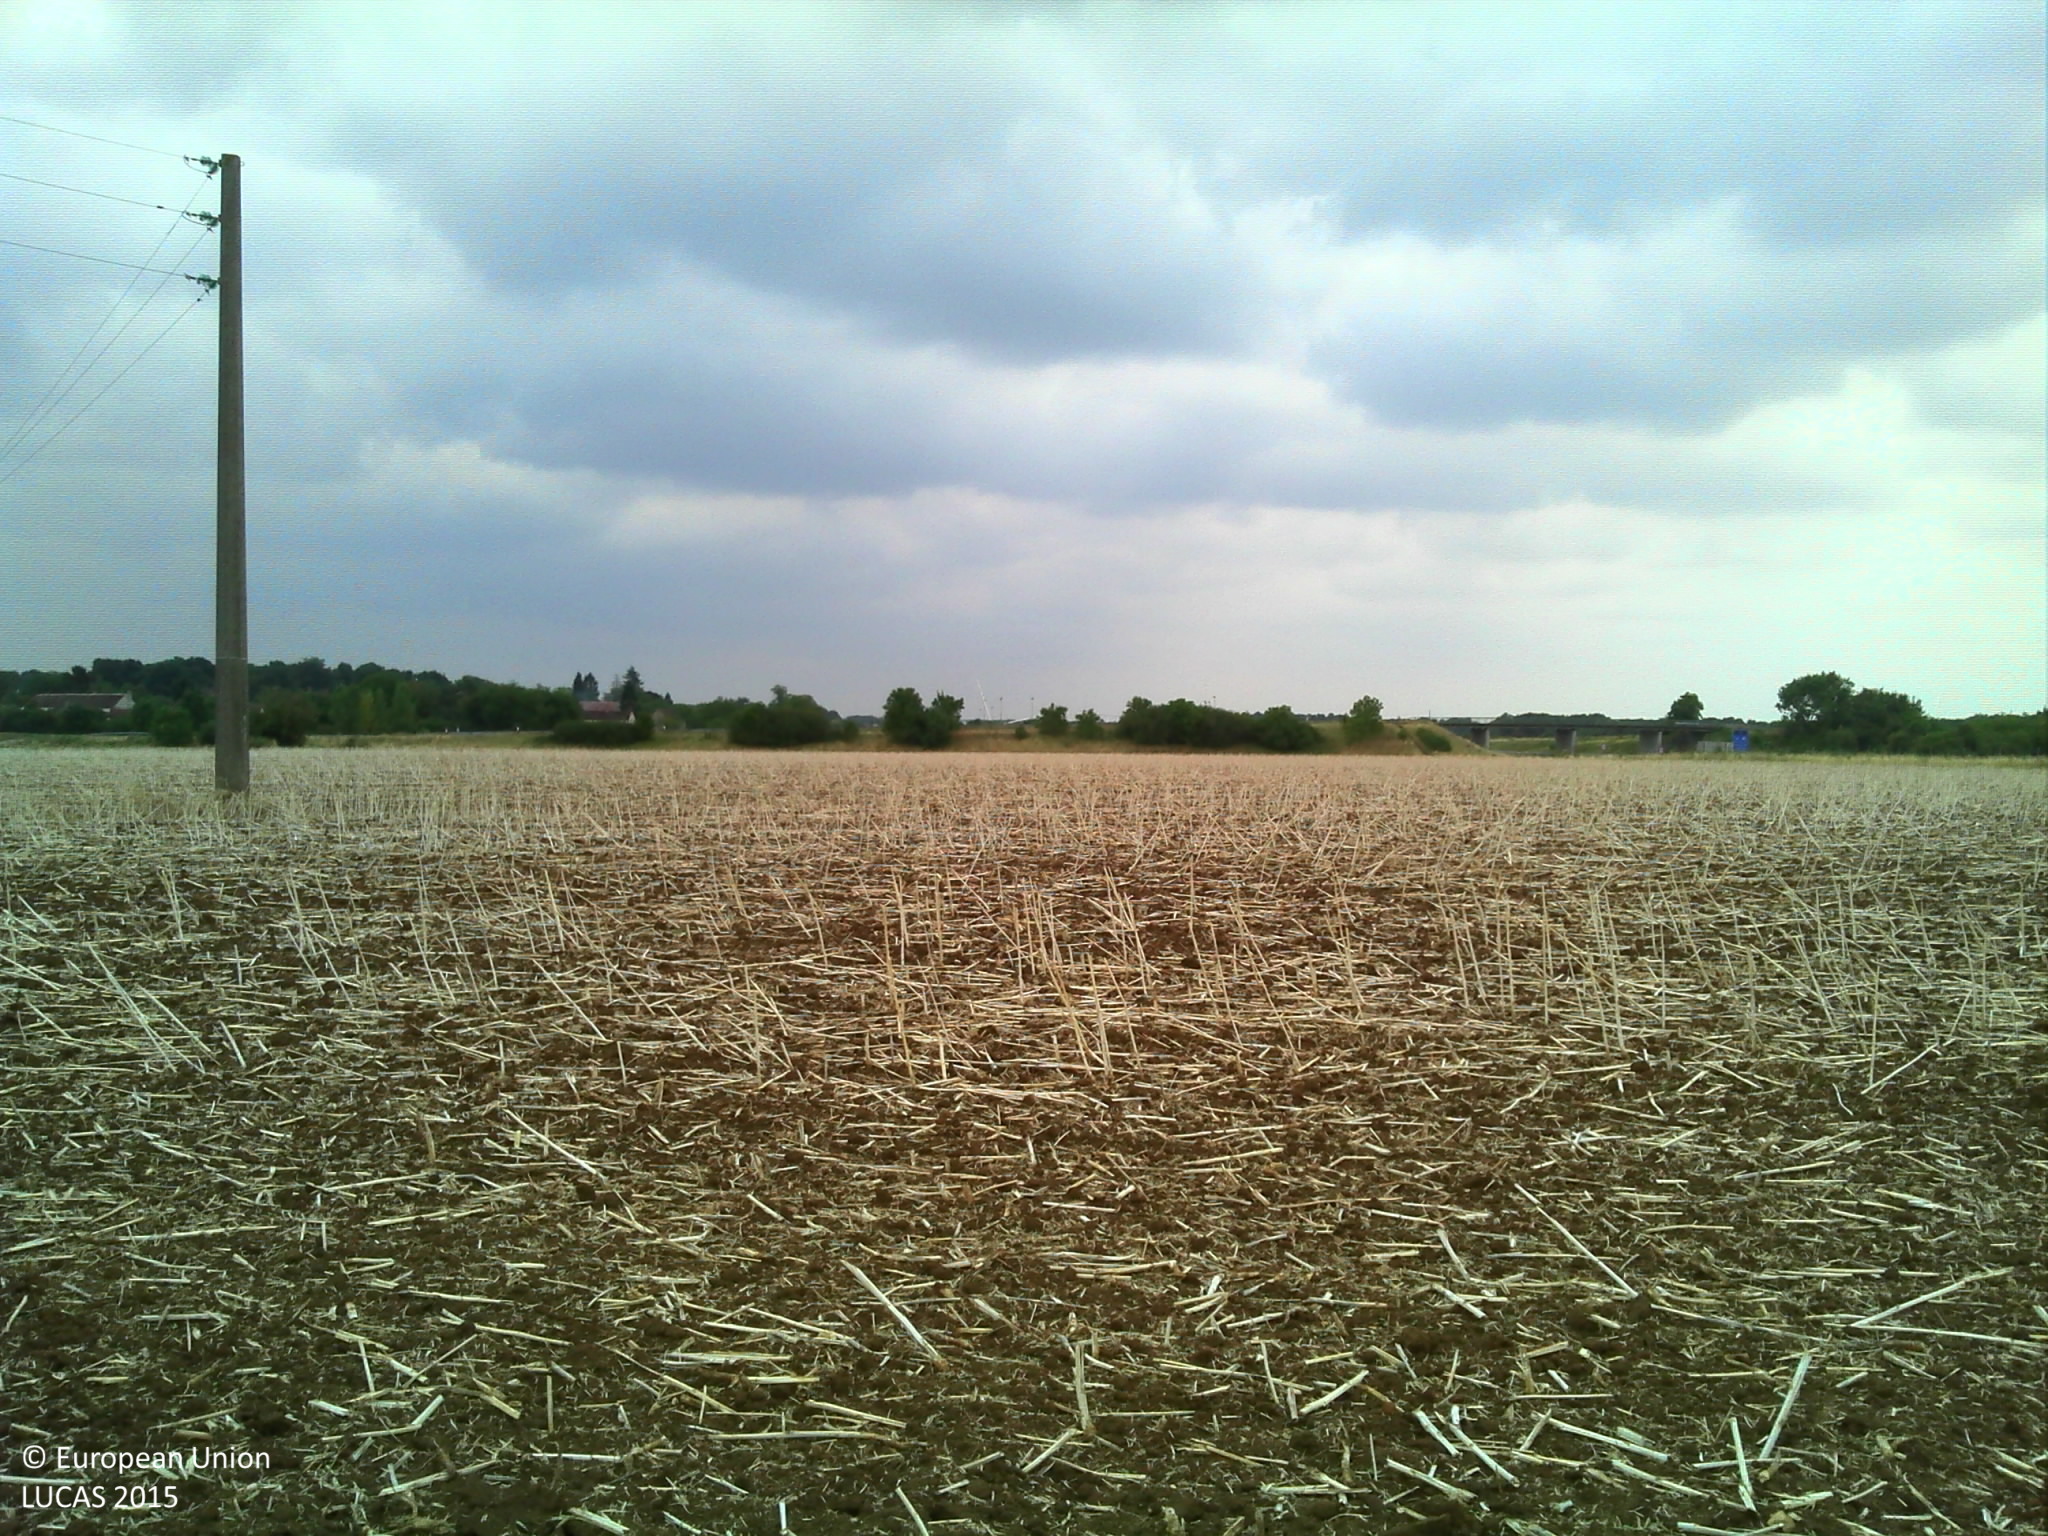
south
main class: Cropland
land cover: Rape and turnip rape
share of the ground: 10 - 25 %
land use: Agriculture (excluding fallow land and kitchen gardens)
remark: Harvested field
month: August
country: FR
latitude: 48.1846
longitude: 2.7685
